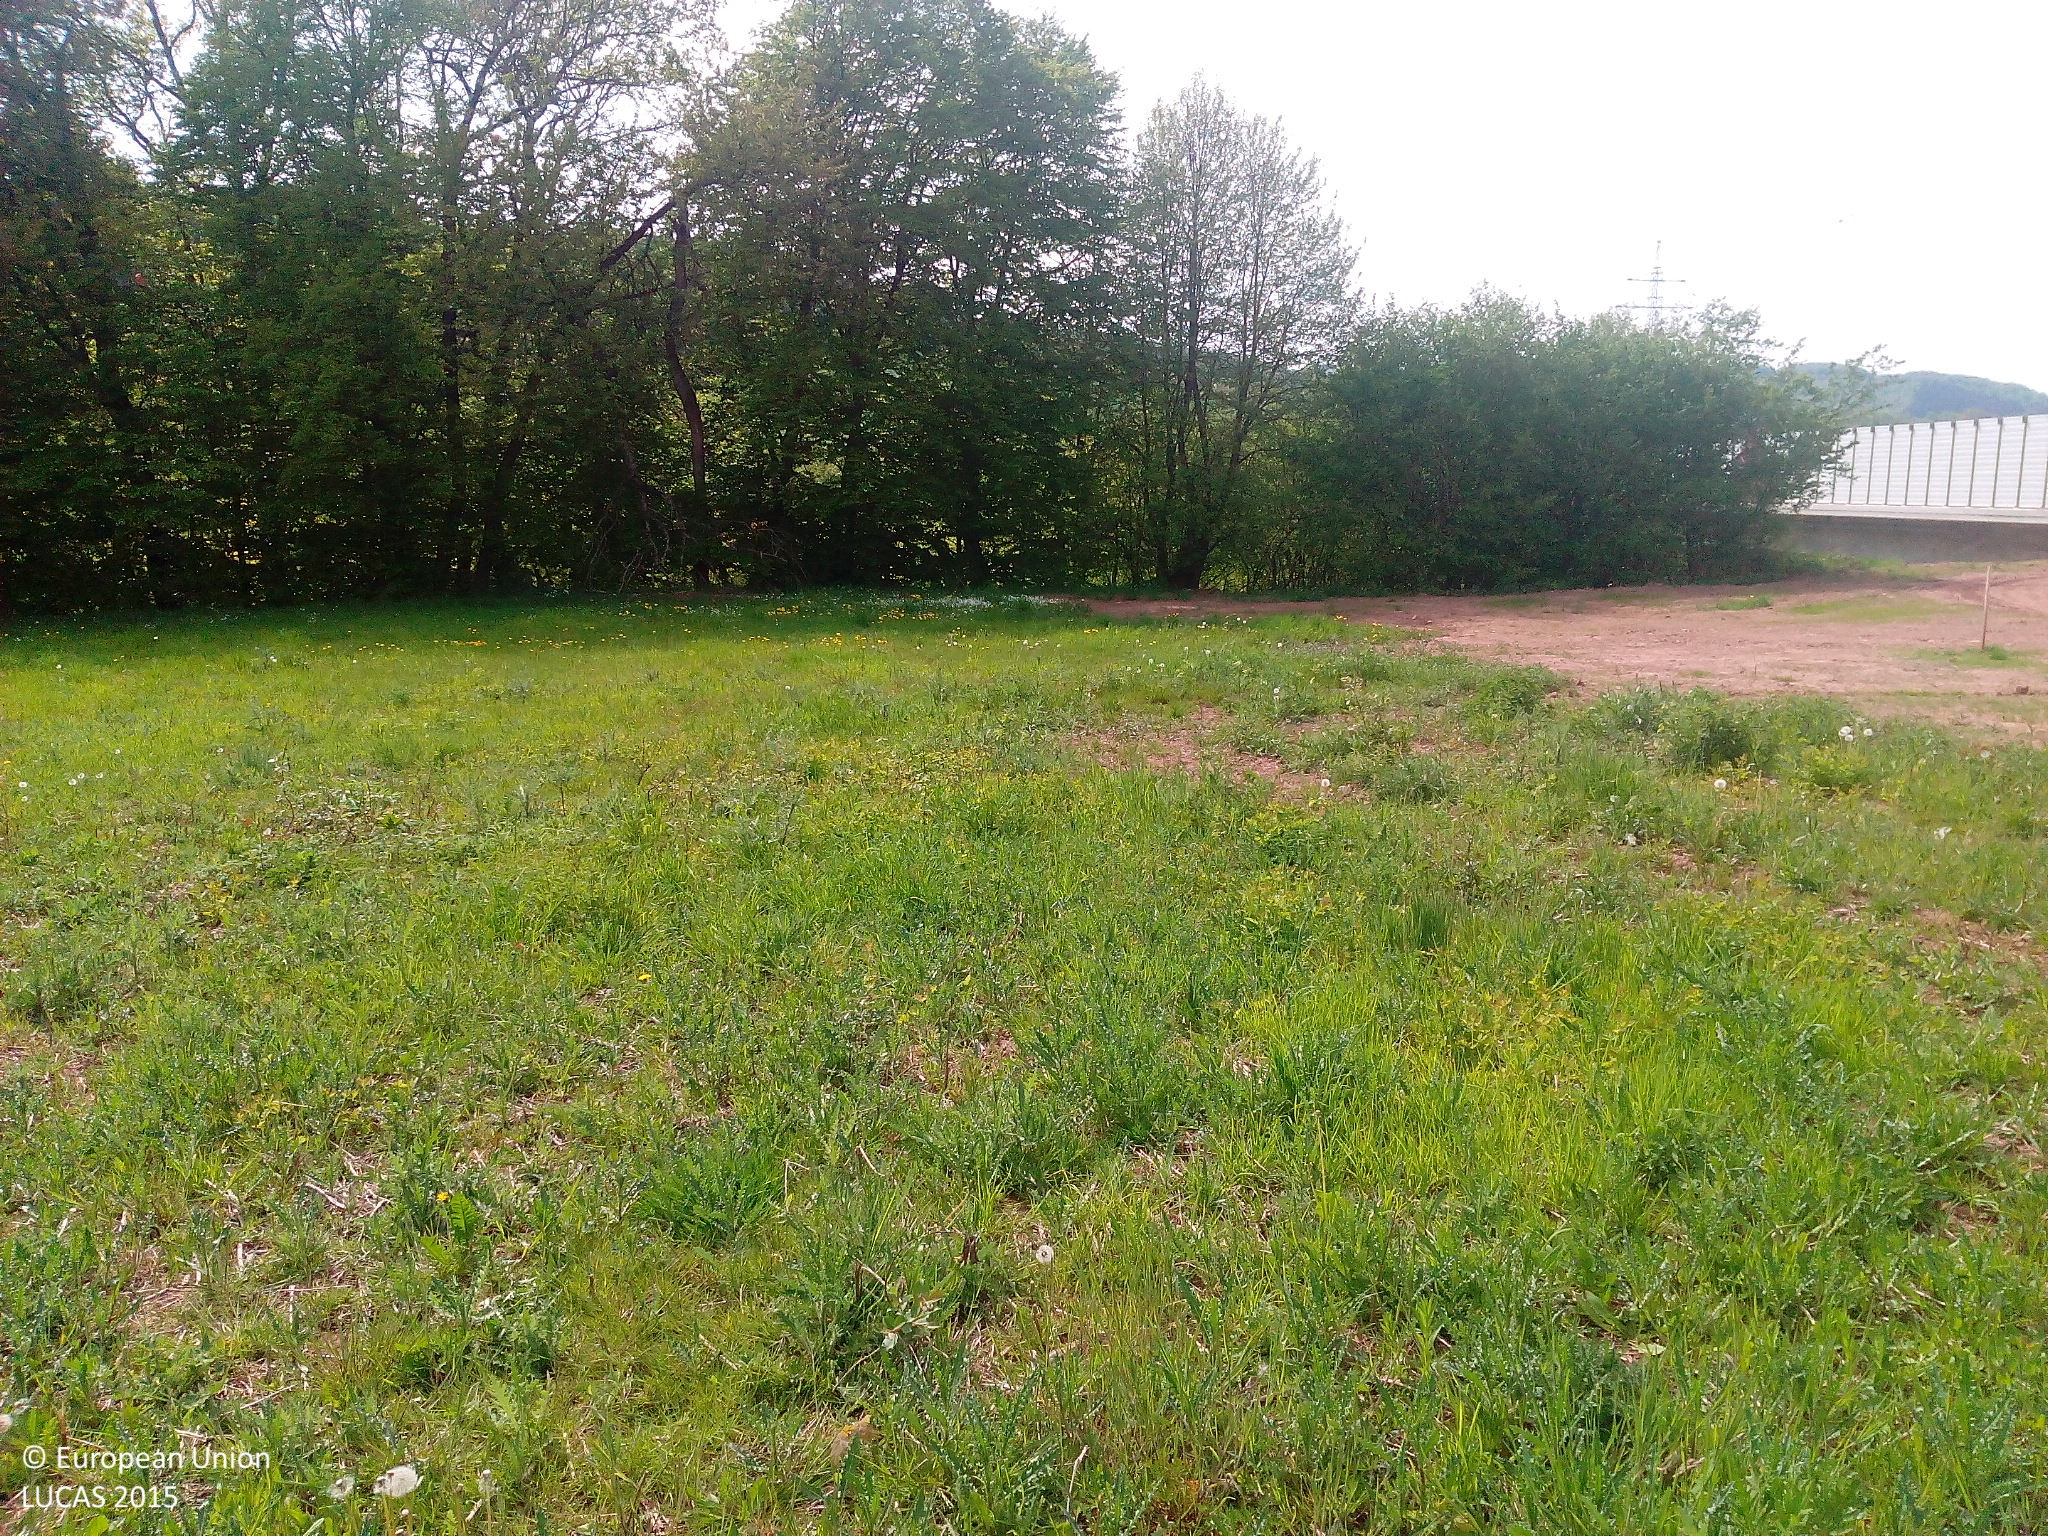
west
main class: Grassland
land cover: Spontaneously vegetated surfaces
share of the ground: > 75 %
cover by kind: herbaceous plants 80 %, unconsolidated bare surface 20 %
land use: Fallow land
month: May
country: DE
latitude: 51.1551
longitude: 9.8714
